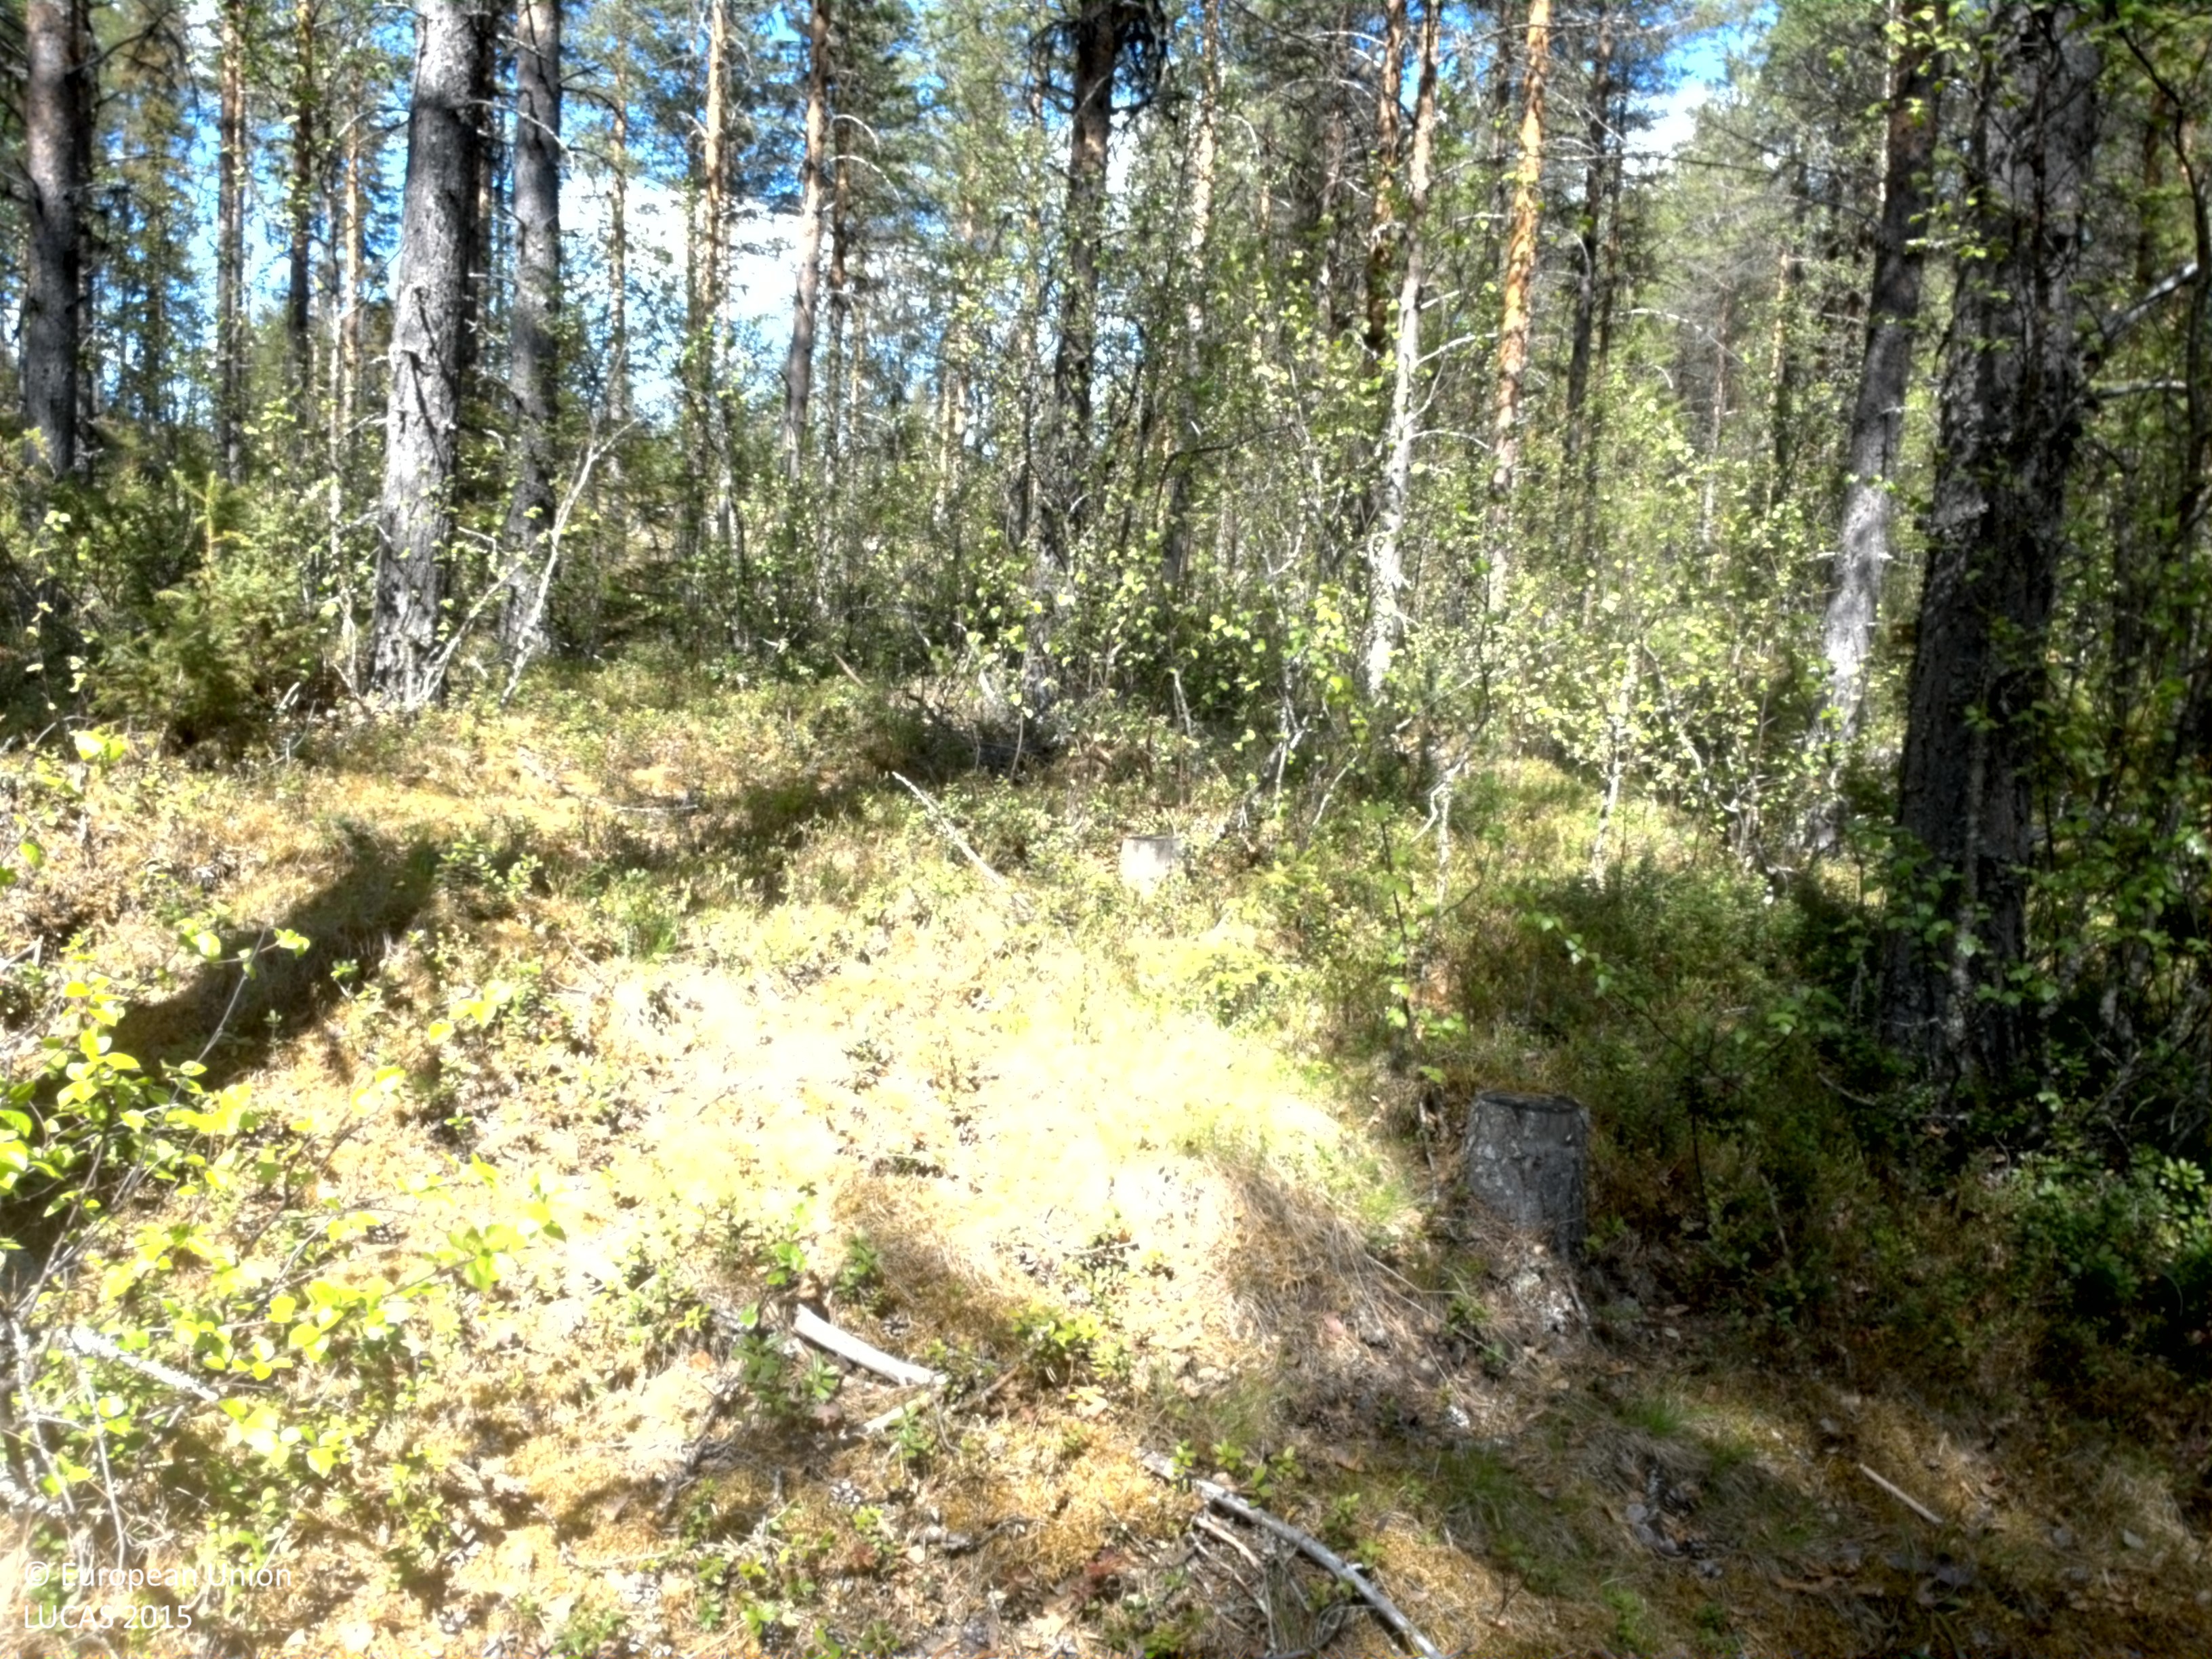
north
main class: Woodland
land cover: Pine dominated mixed woodland
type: boreal forest
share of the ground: 50 - 75 %
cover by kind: coniferous forest trees 45 %, shrubs 35 %, broadleaved forest trees 20 %
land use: Forestry
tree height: > 5 m
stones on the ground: 10 - 25 %
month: June
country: SE
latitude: 65.8069
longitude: 18.8582
